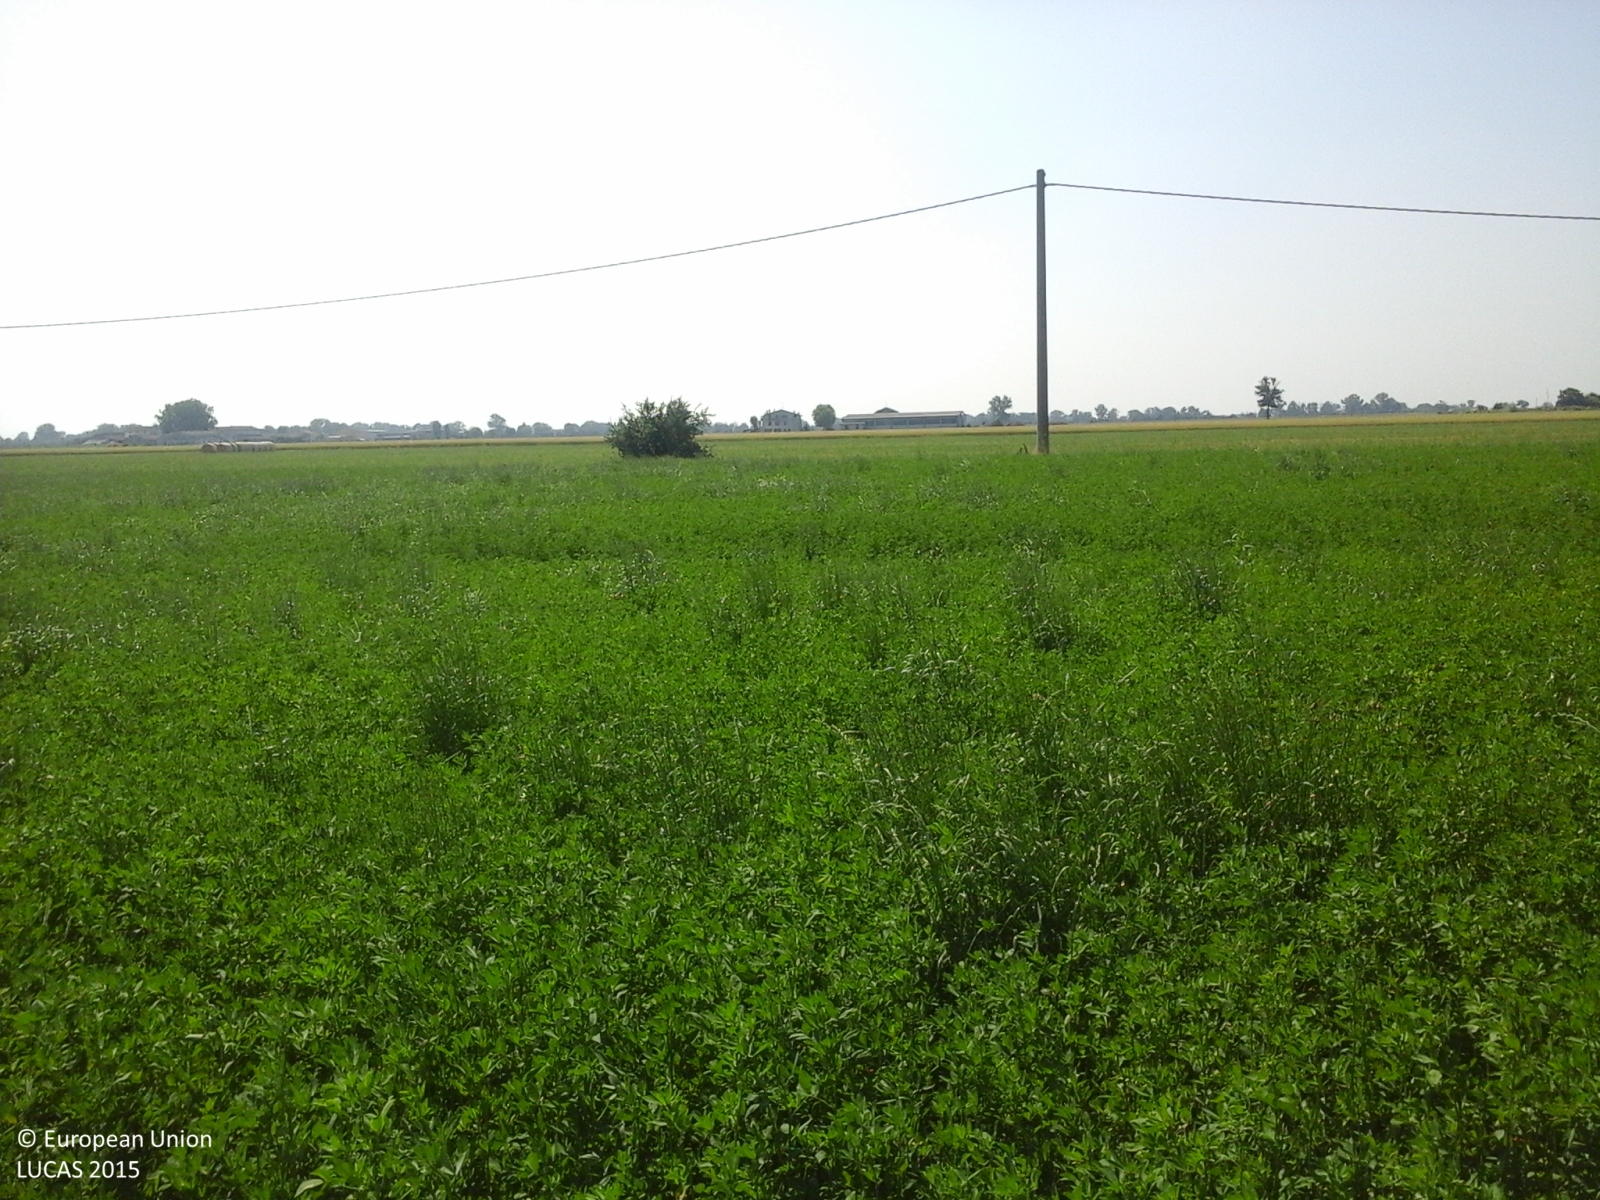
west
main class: Cropland
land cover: Lucerne
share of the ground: > 75 %
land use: Agriculture (excluding fallow land and kitchen gardens)
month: June
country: IT
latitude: 44.9276
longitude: 10.0632
